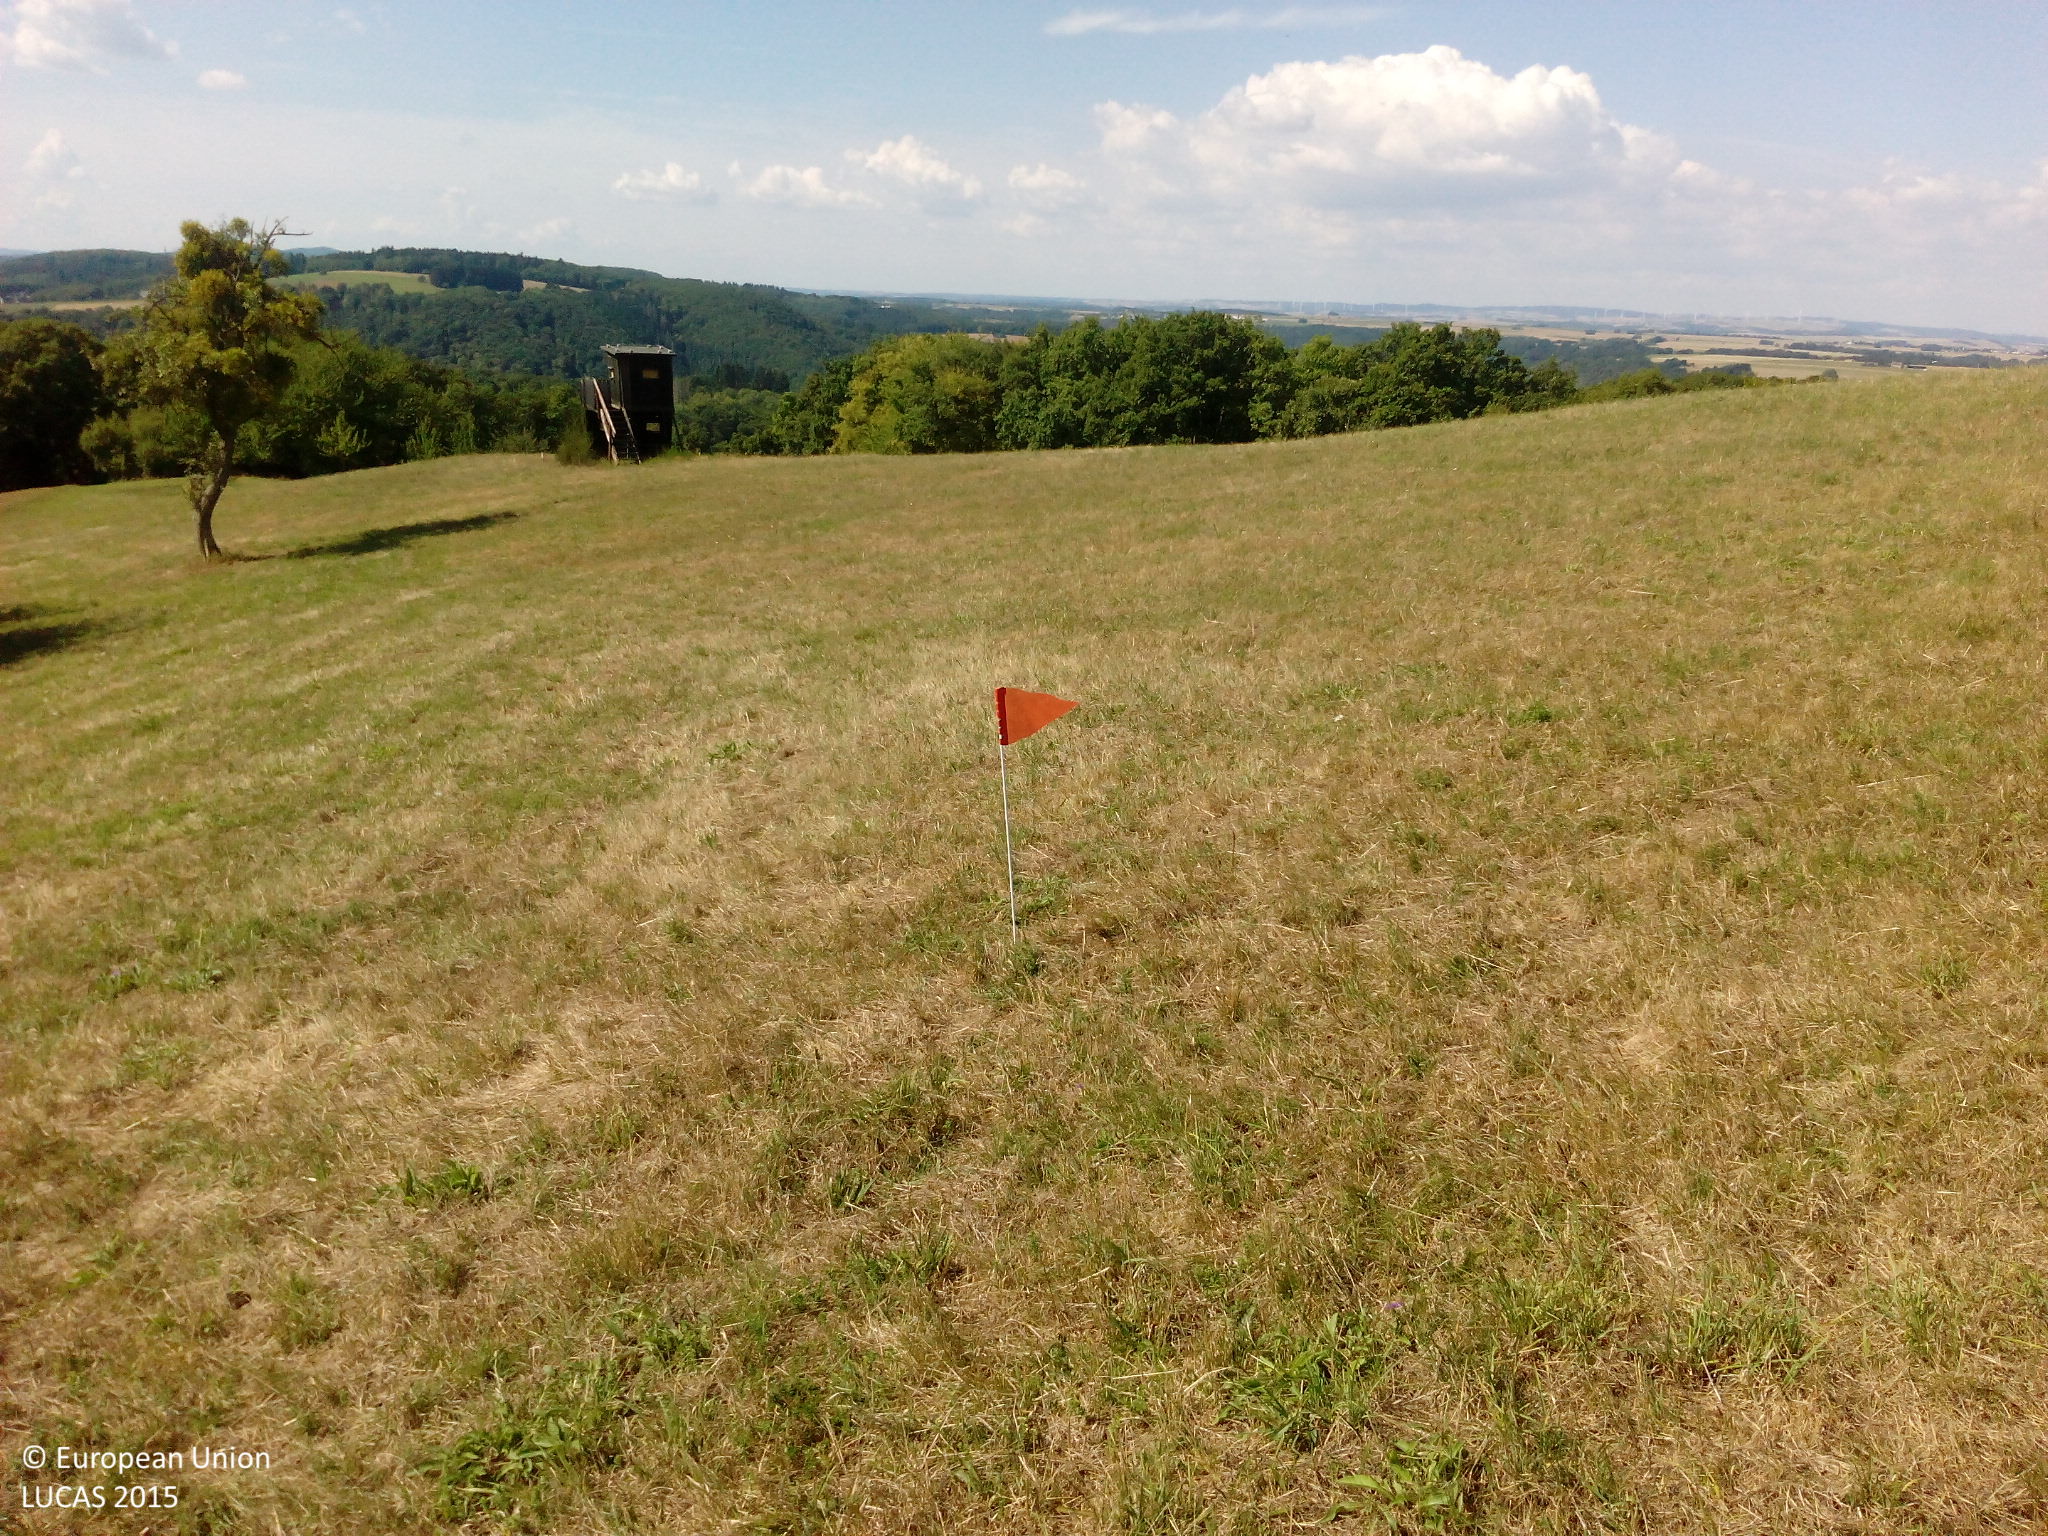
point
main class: Grassland
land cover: Grassland without tree/shrub cover
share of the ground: > 75 %
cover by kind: herbaceous plants 90 %, unconsolidated bare surface 10 %
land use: Agriculture (excluding fallow land and kitchen gardens)
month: August
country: DE
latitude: 50.2280
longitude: 7.4631
